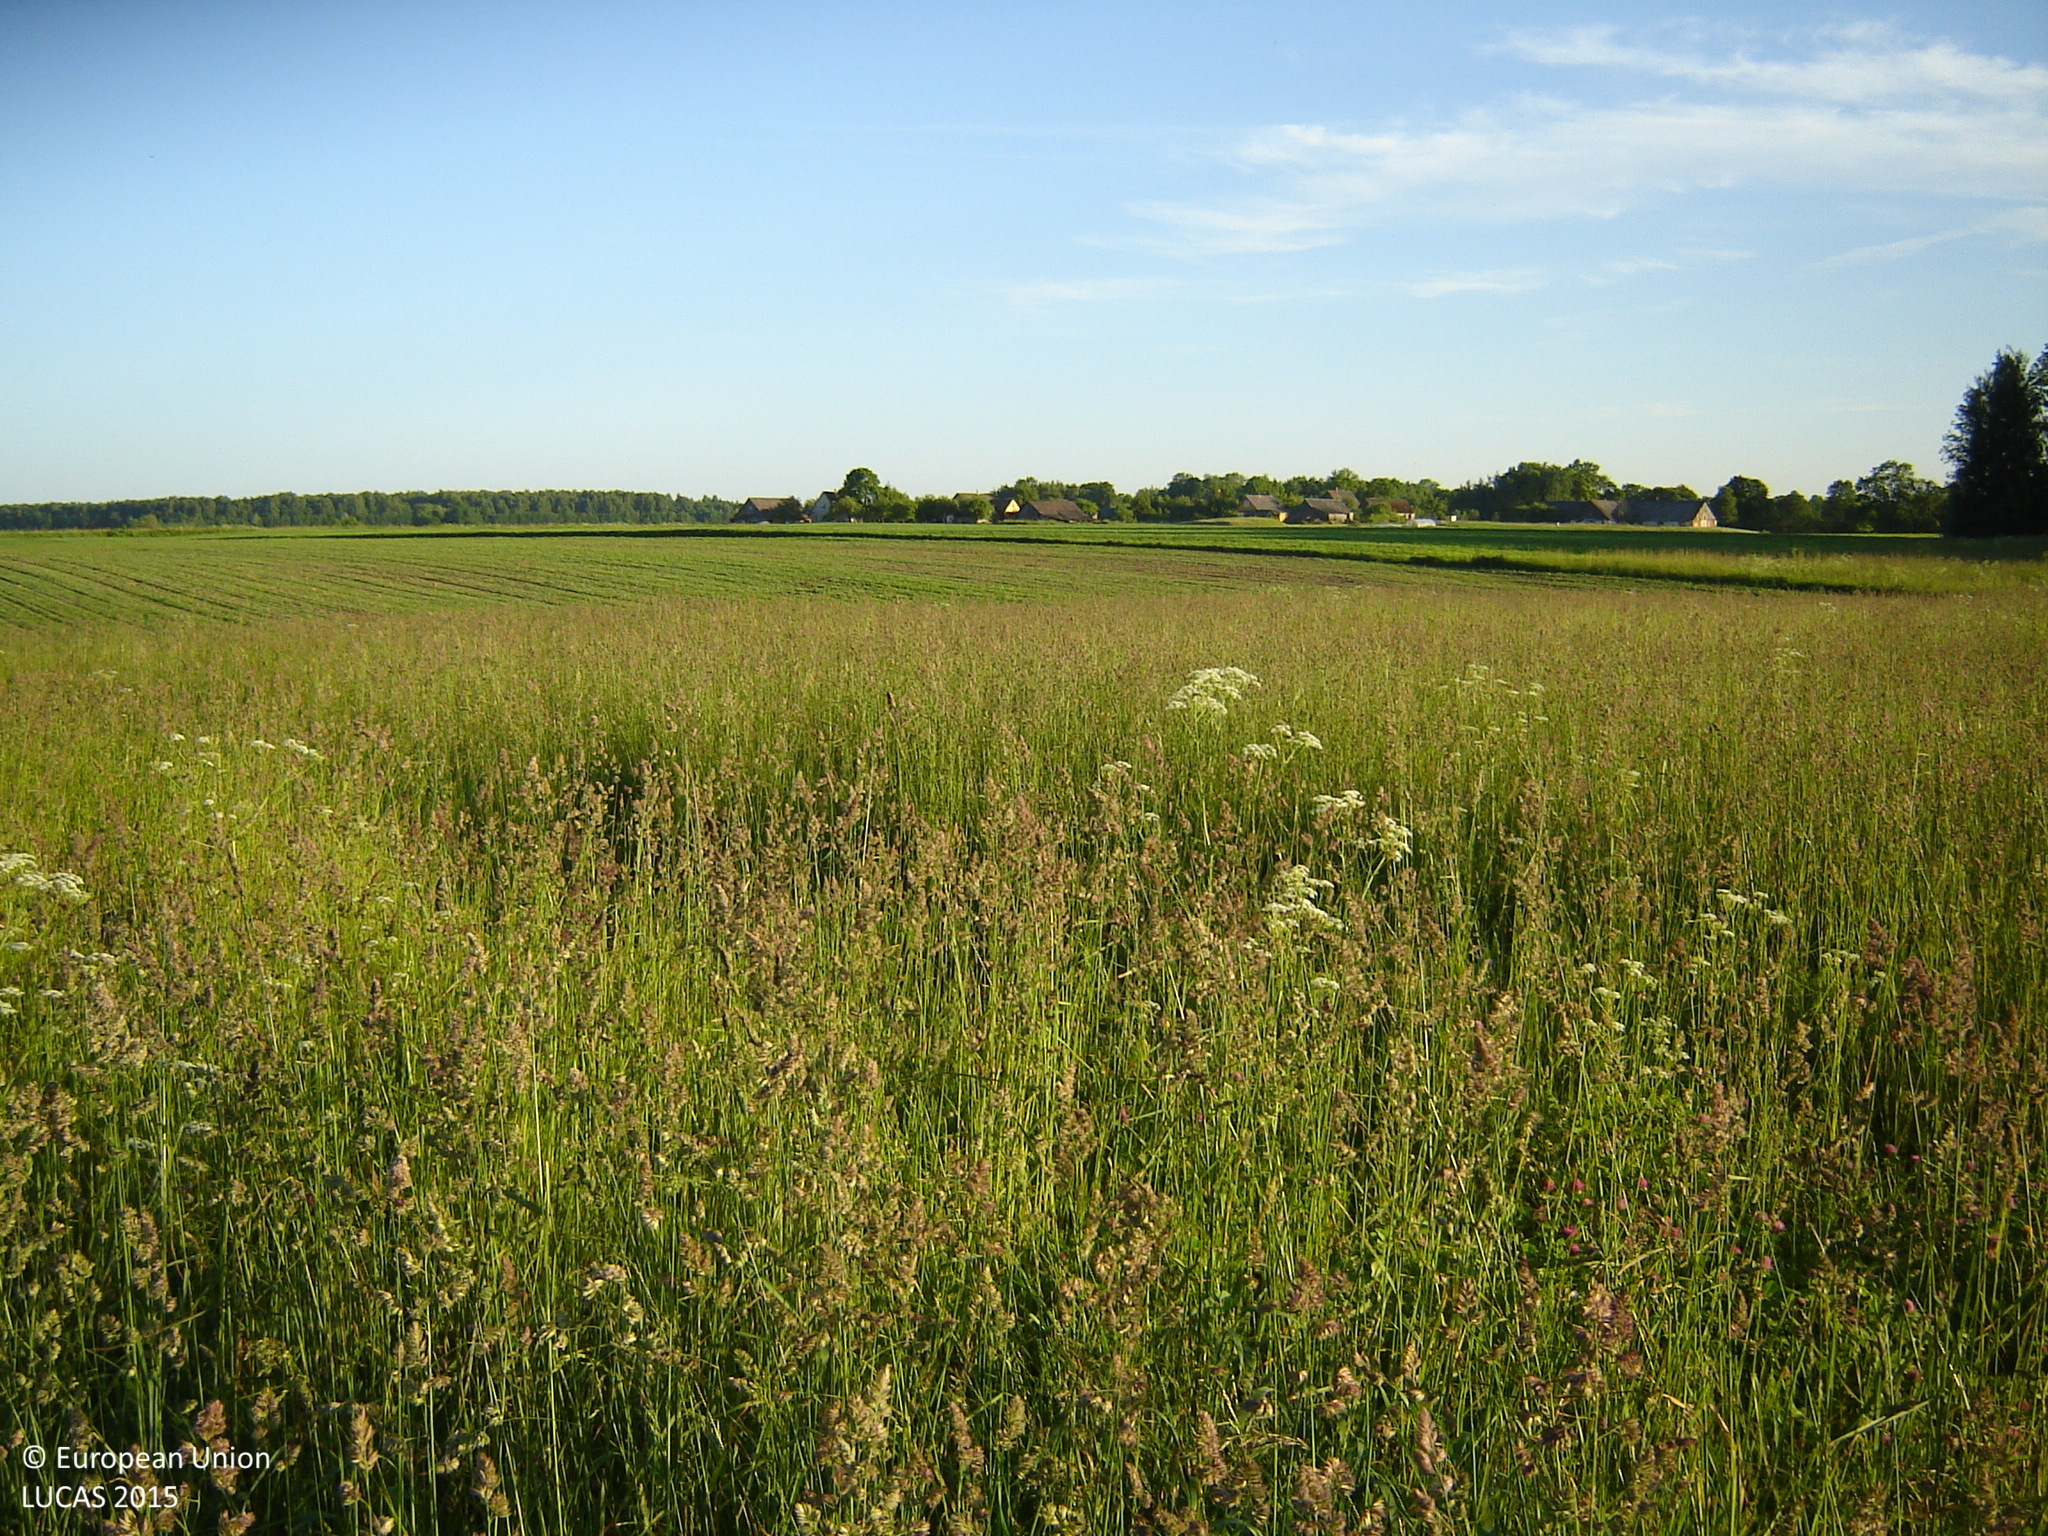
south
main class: Grassland
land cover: Grassland without tree/shrub cover
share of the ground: > 75 %
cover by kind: herbaceous plants 100 %
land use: Agriculture (excluding fallow land and kitchen gardens)
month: June
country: LT
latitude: 55.5468
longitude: 25.2217
